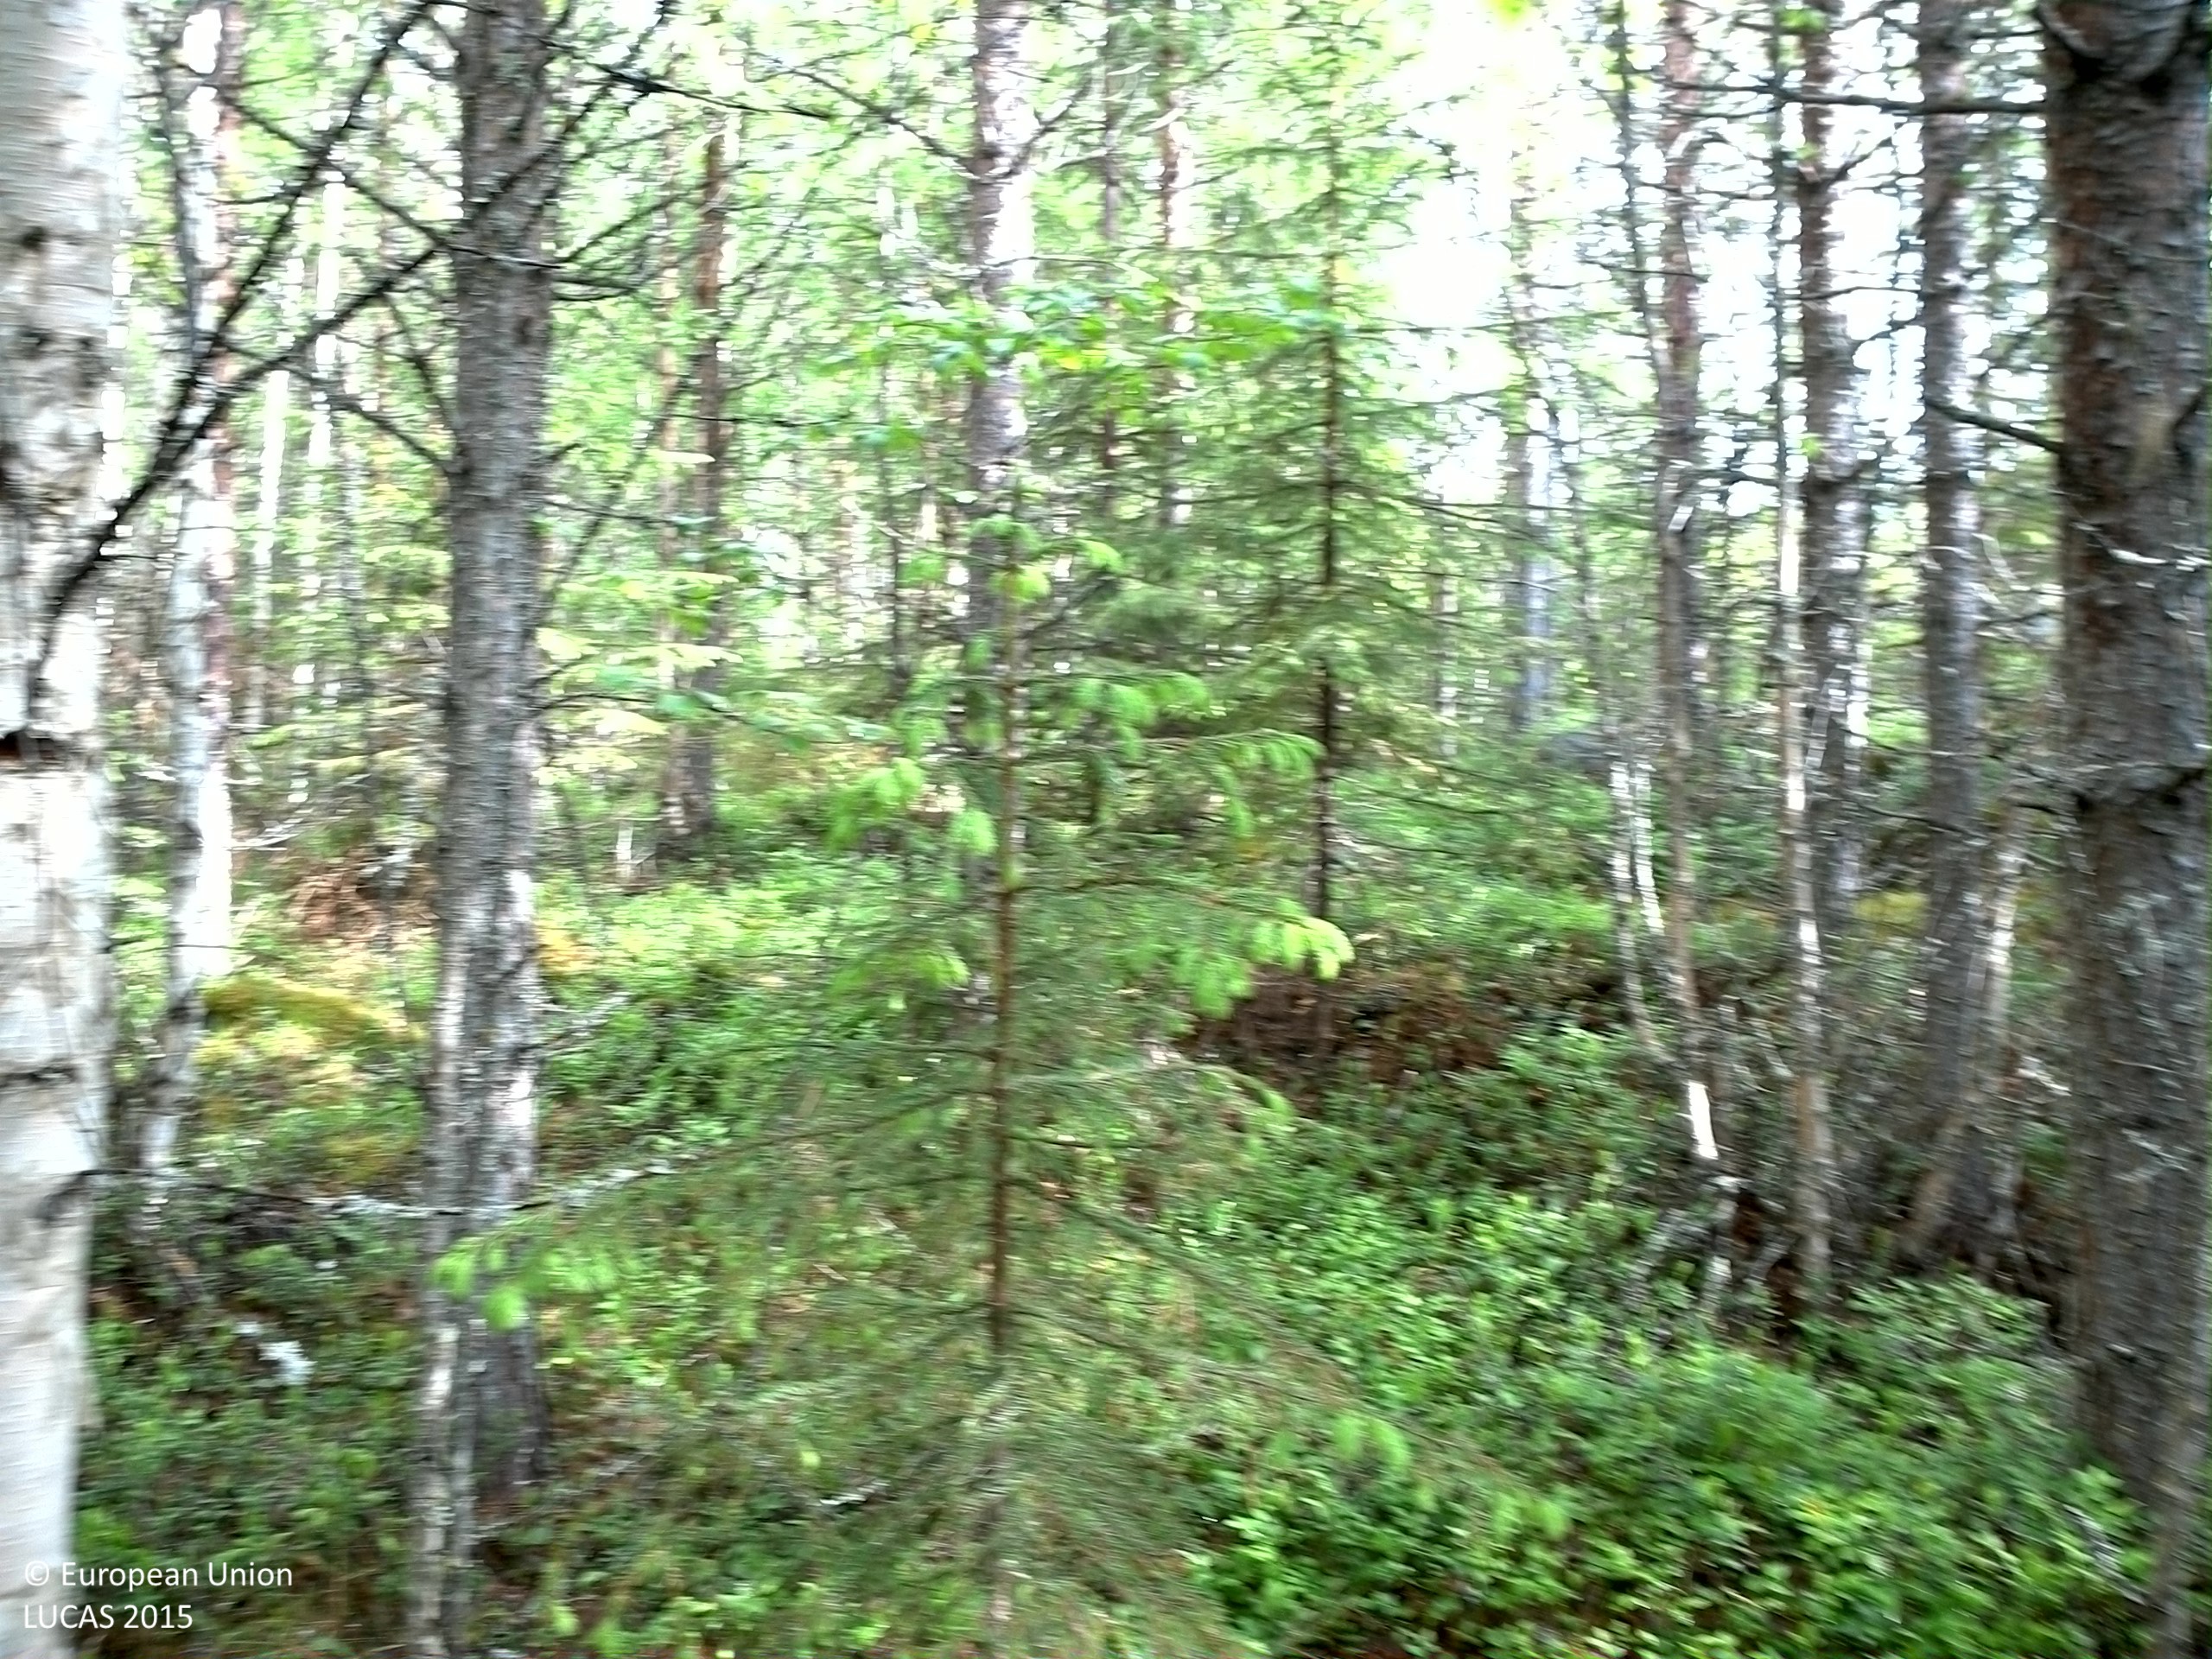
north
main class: Woodland
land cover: Pine dominated mixed woodland
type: boreal forest
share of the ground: 50 - 75 %
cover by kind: coniferous forest trees 40 %, broadleaved forest trees 30 %, shrubs 25 %, lichens and mosses 5 %
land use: Forestry
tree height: > 5 m
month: June
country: SE
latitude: 63.4847
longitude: 18.0661
